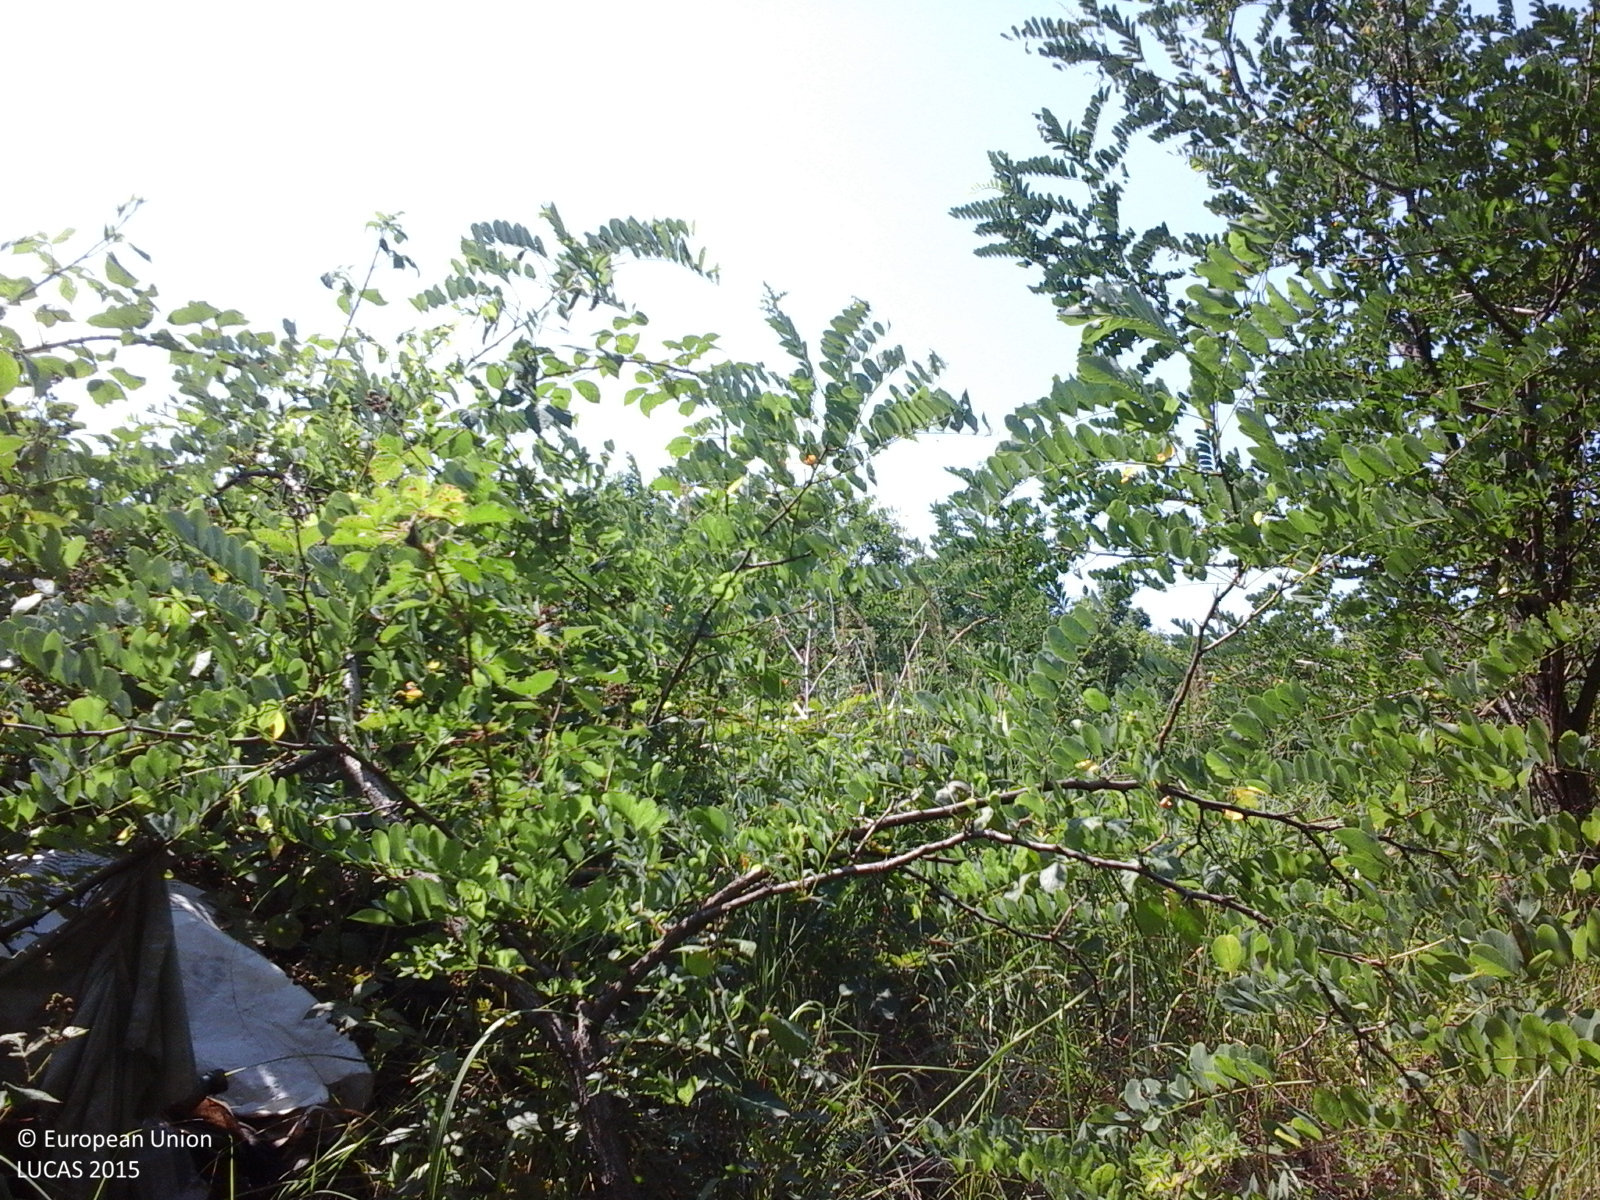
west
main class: Woodland
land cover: Broadleaved woodland
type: acidophilous oak and oak-birch forest
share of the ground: > 75 %
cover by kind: broadleaved forest trees 80 %, shrubs 10 %, herbaceous plants 10 %
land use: Forestry
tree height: > 5 m
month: July
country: RO
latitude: 44.7234
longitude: 24.5811
